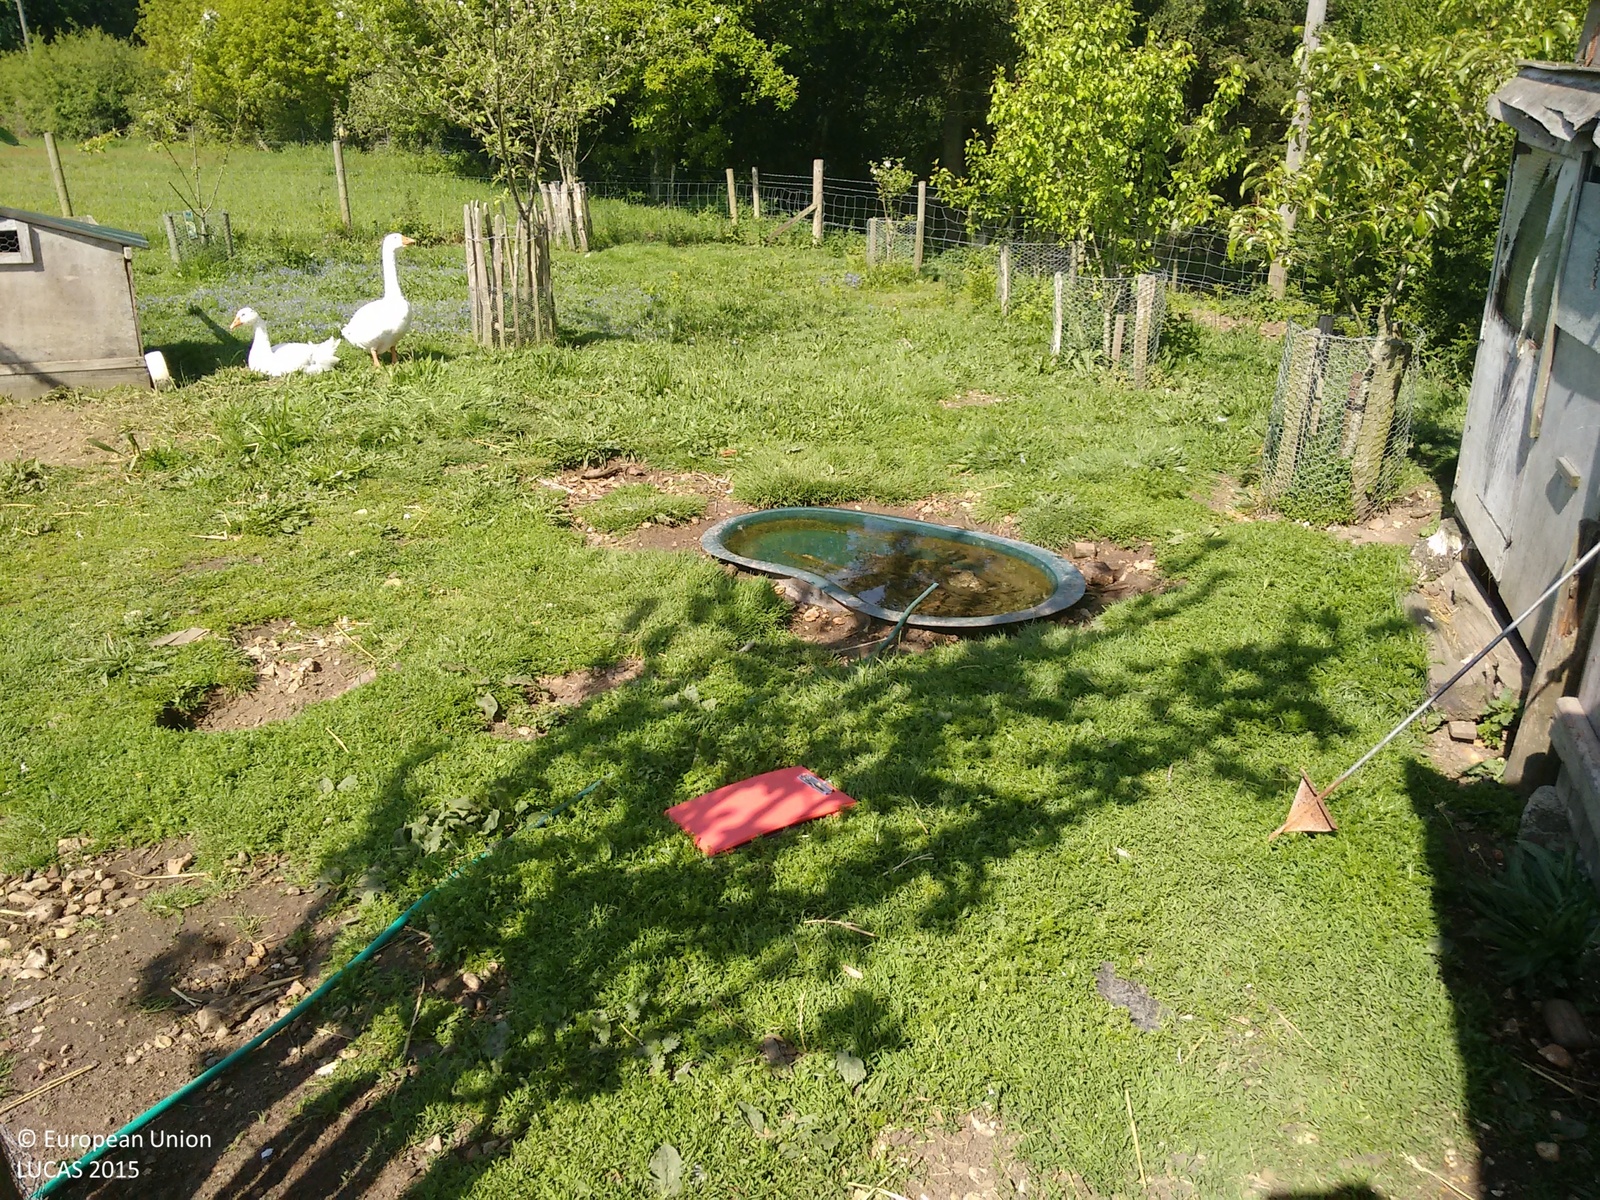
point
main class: Grassland
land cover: Grassland with sparse tree/shrub cover
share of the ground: > 75 %
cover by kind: herbaceous plants 95 %, broadleaved forest trees 5 %
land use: Agriculture (excluding fallow land and kitchen gardens)
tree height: < 5 m
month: May
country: GB
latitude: 50.6851
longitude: -2.2484
